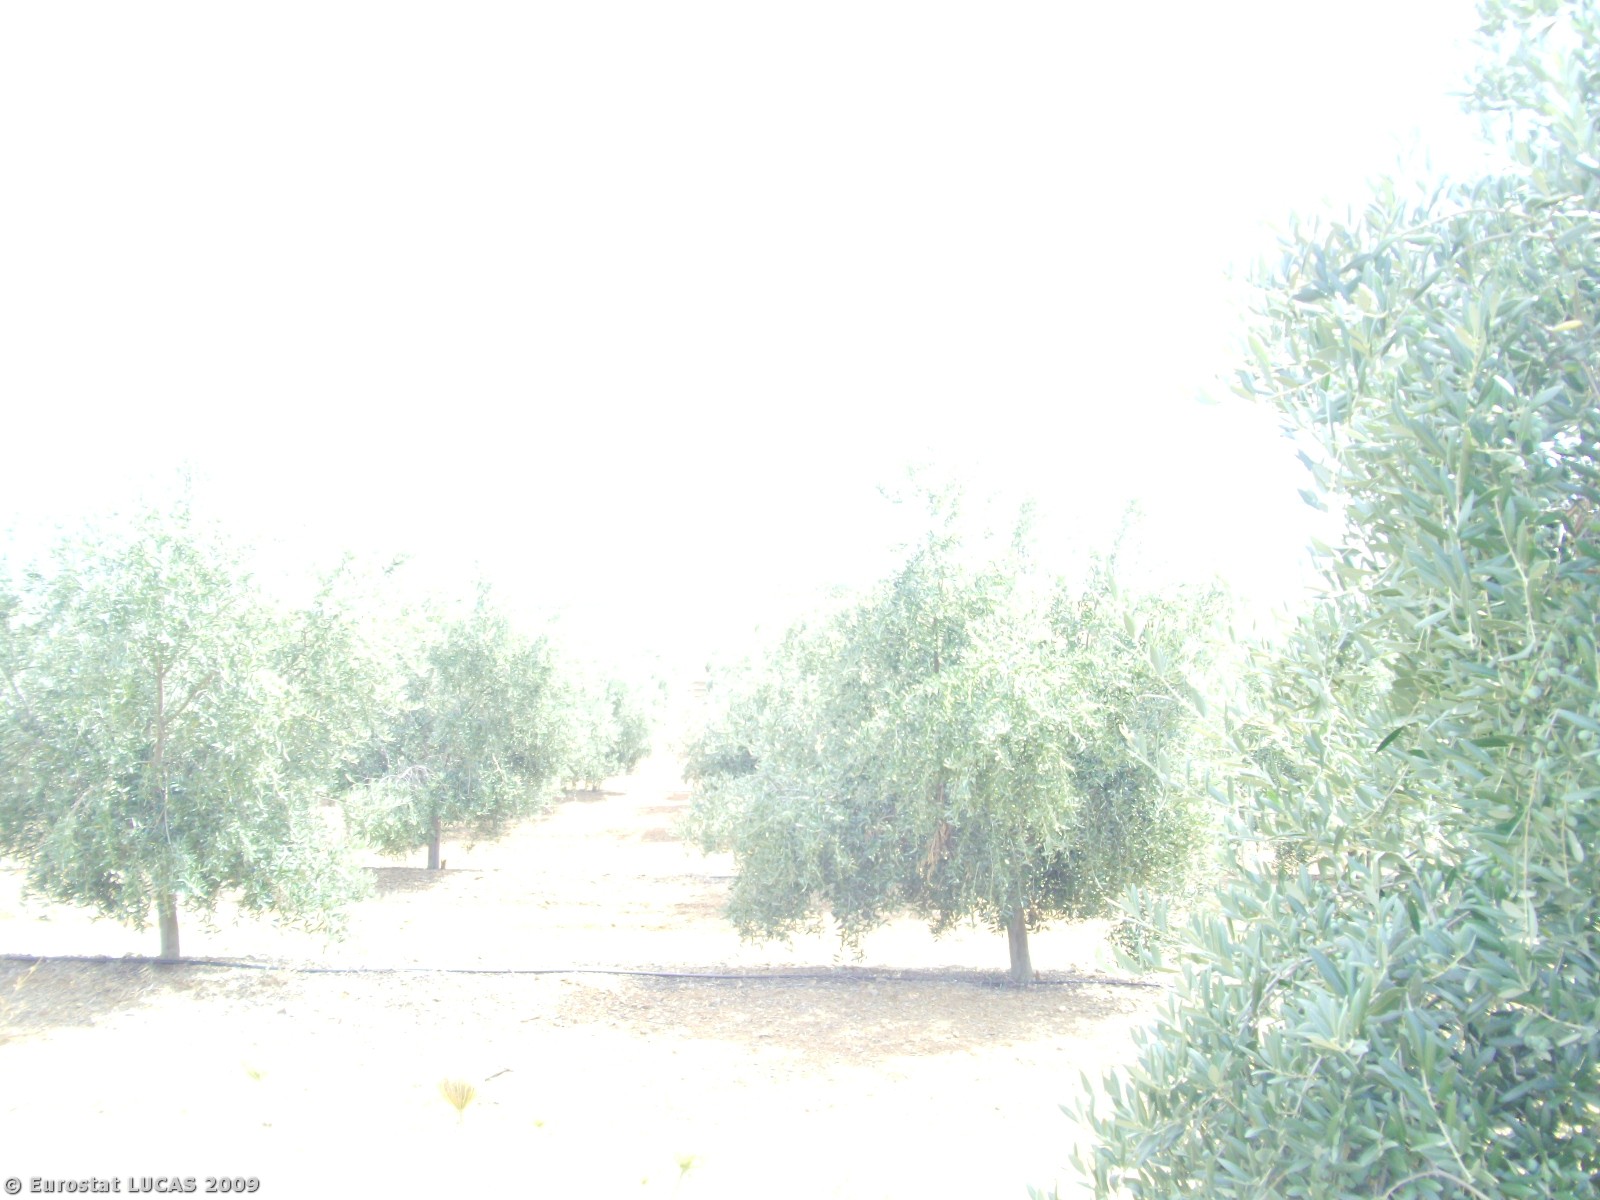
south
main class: Cropland
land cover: Olive groves
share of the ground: 50 - 75 %
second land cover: Spontaneously vegetated surfaces
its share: 10 - 25 %
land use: Agriculture (excluding fallow land and kitchen gardens)
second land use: Fallow land
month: August
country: PT
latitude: 38.0697
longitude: -7.7046
